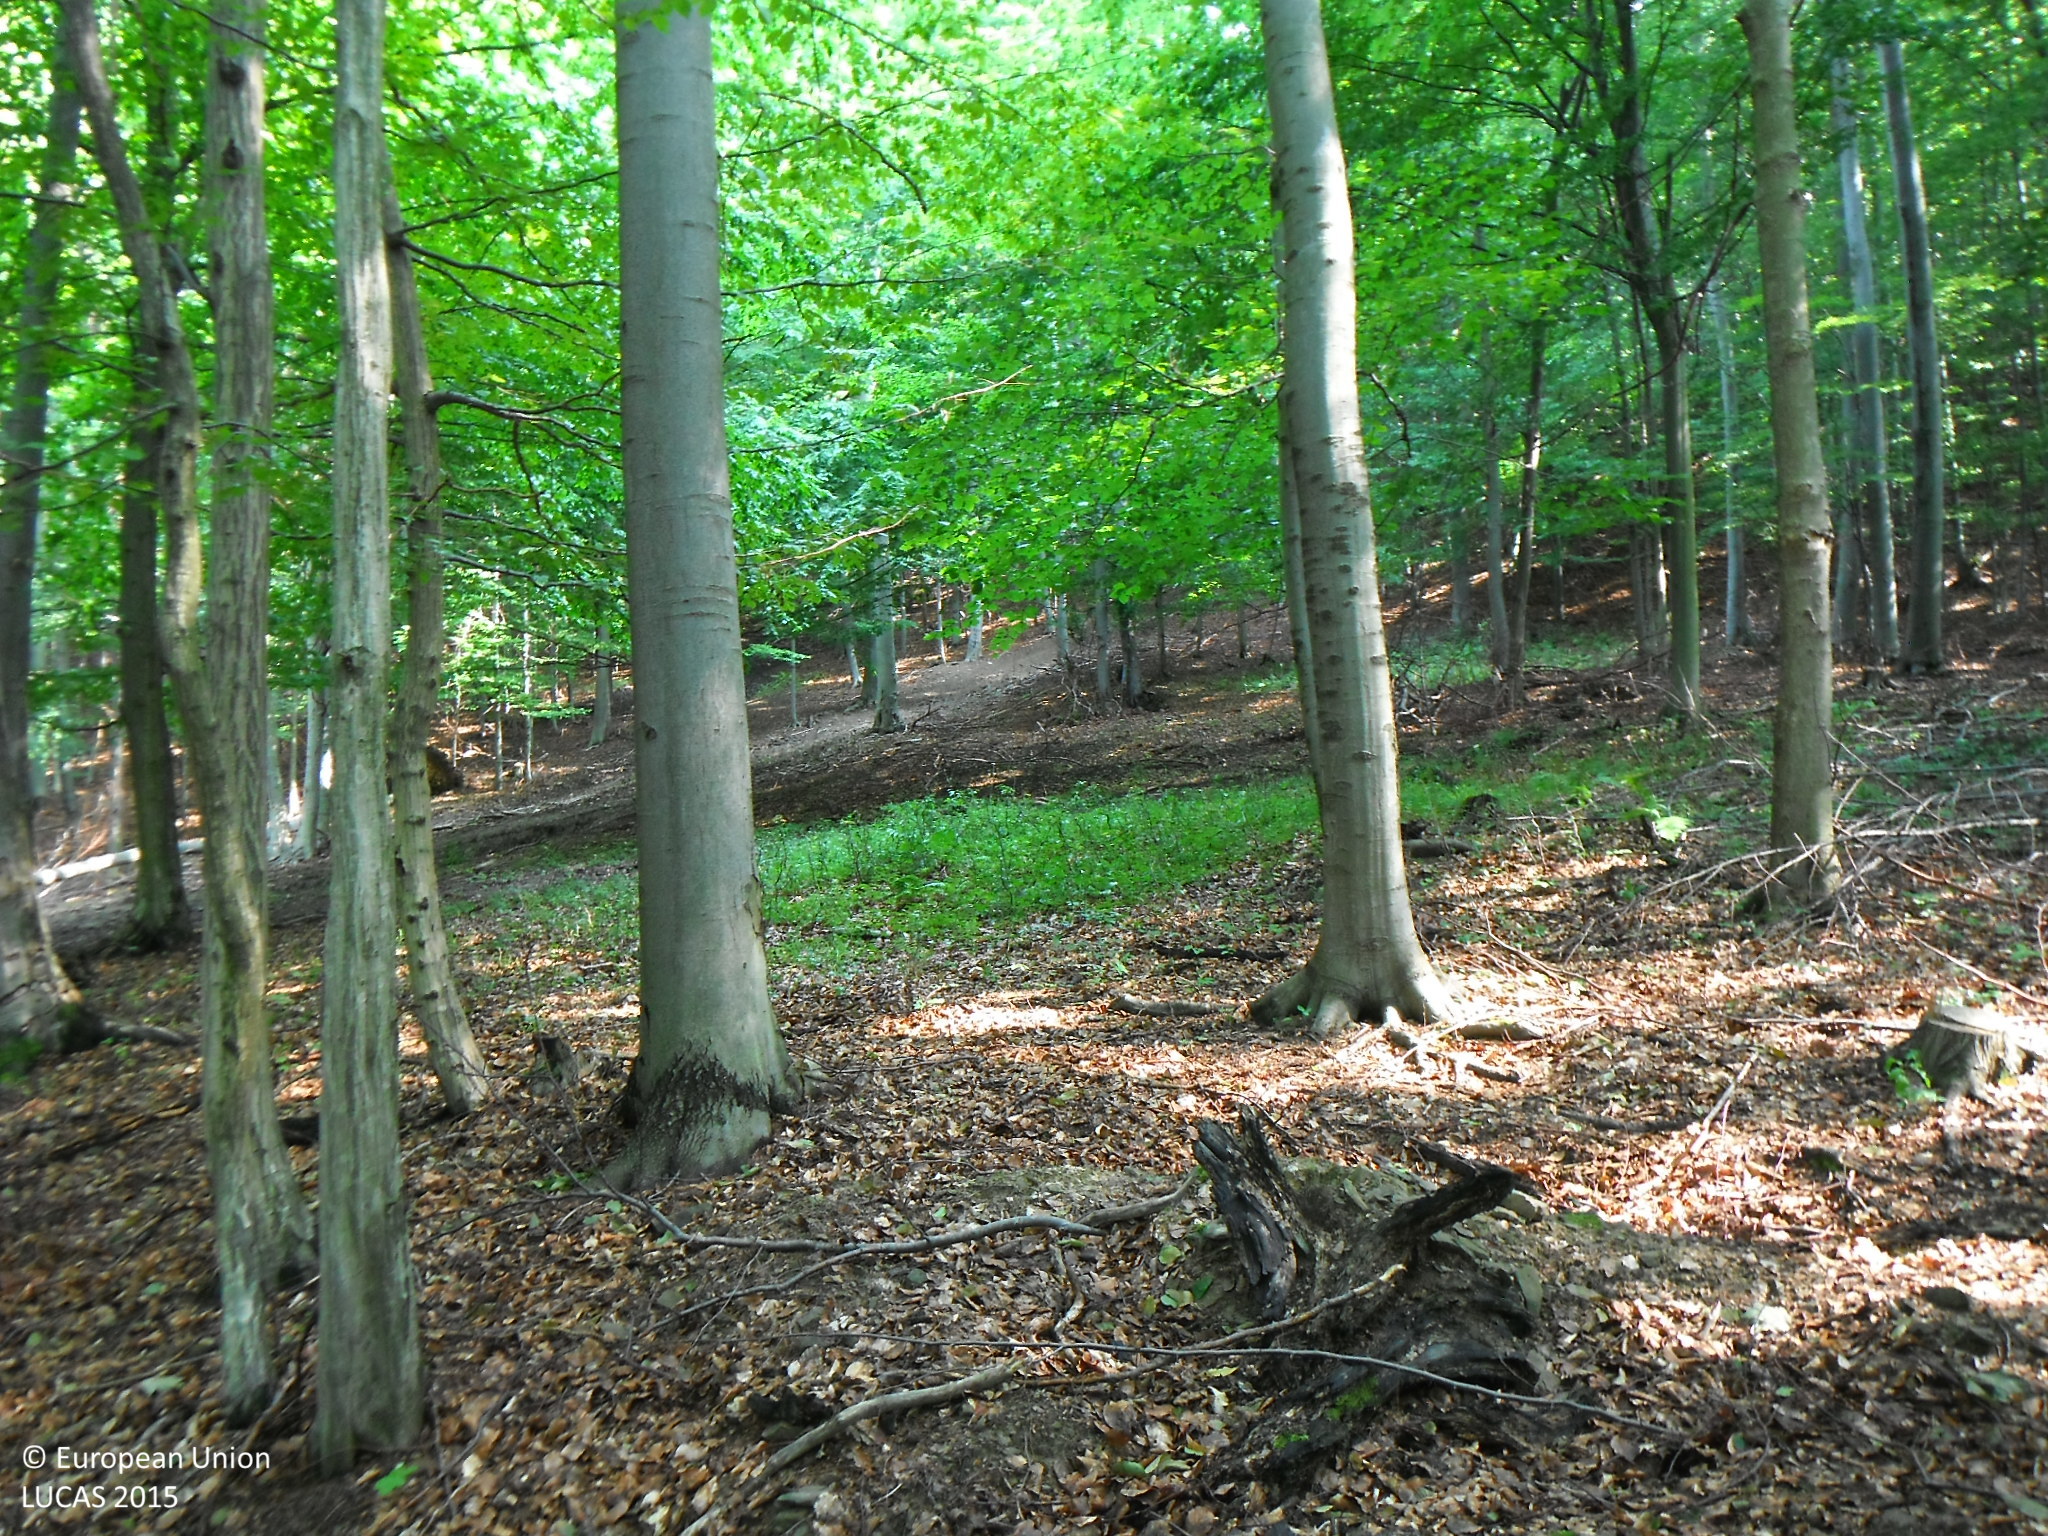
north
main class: Woodland
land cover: Broadleaved woodland
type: beech forest
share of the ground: > 75 %
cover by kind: broadleaved forest trees 95 %, herbaceous plants 5 %
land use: Forestry
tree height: > 5 m
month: July
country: SK
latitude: 49.3870
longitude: 21.2738
